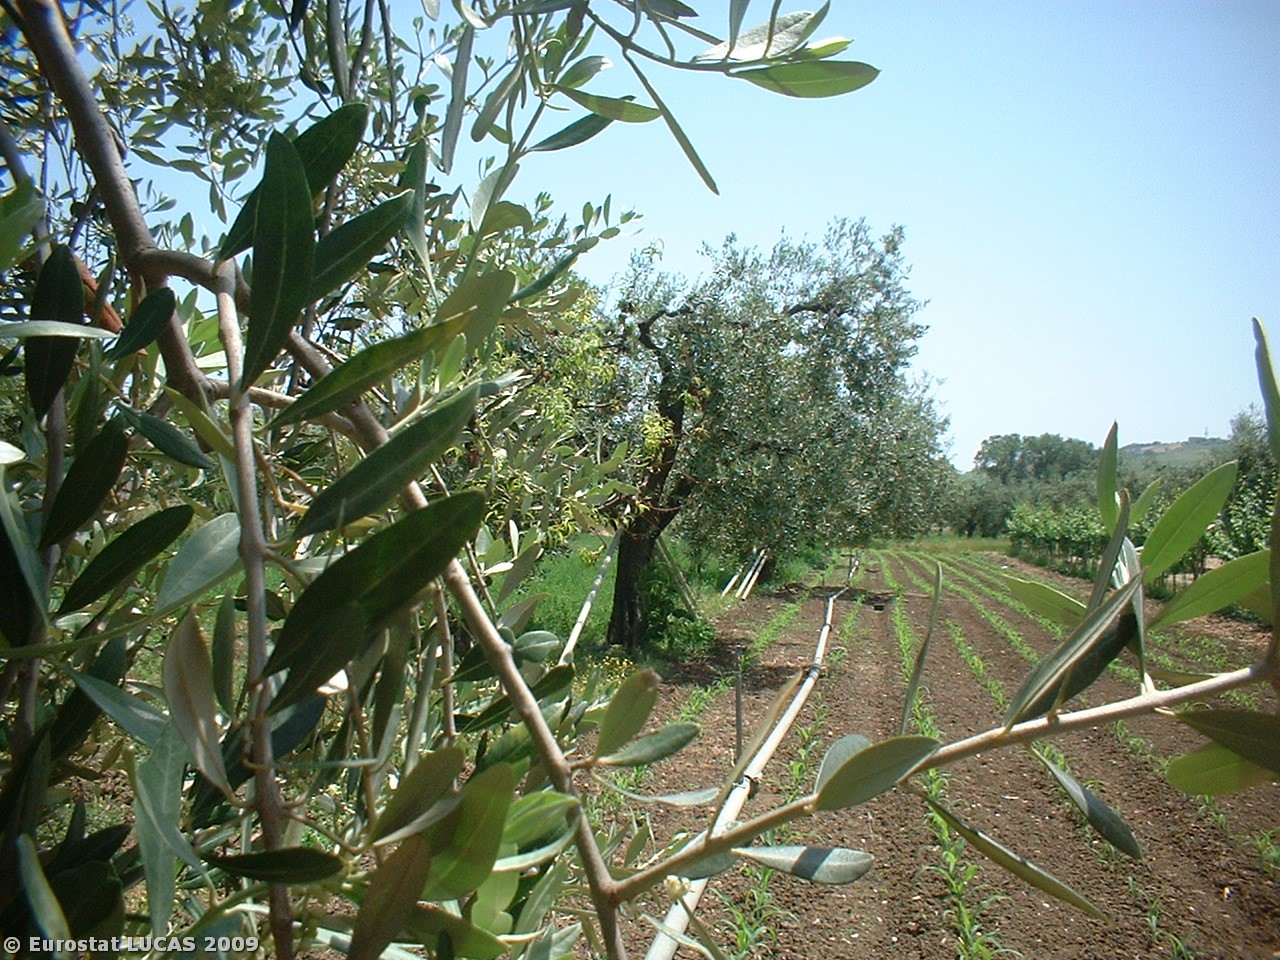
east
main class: Cropland
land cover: Maize
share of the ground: 10 - 25 %
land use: Agriculture (excluding fallow land and kitchen gardens)
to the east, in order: Maize; Olive groves; Bare land; Electric lines; Olive groves; Grassland with sparse tree/shrub cover; Grass margins; Paved roads, cycling and walking lanes; Grass margins; Grassland without tree/shrub cover; Tomatoes; Artificial constructions in urban areas; Potatoes; Olive groves; Grassland with sparse tree/shrub cover; Managed hedges; Bare land
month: May
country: IT
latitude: 43.2174
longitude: 13.7451
